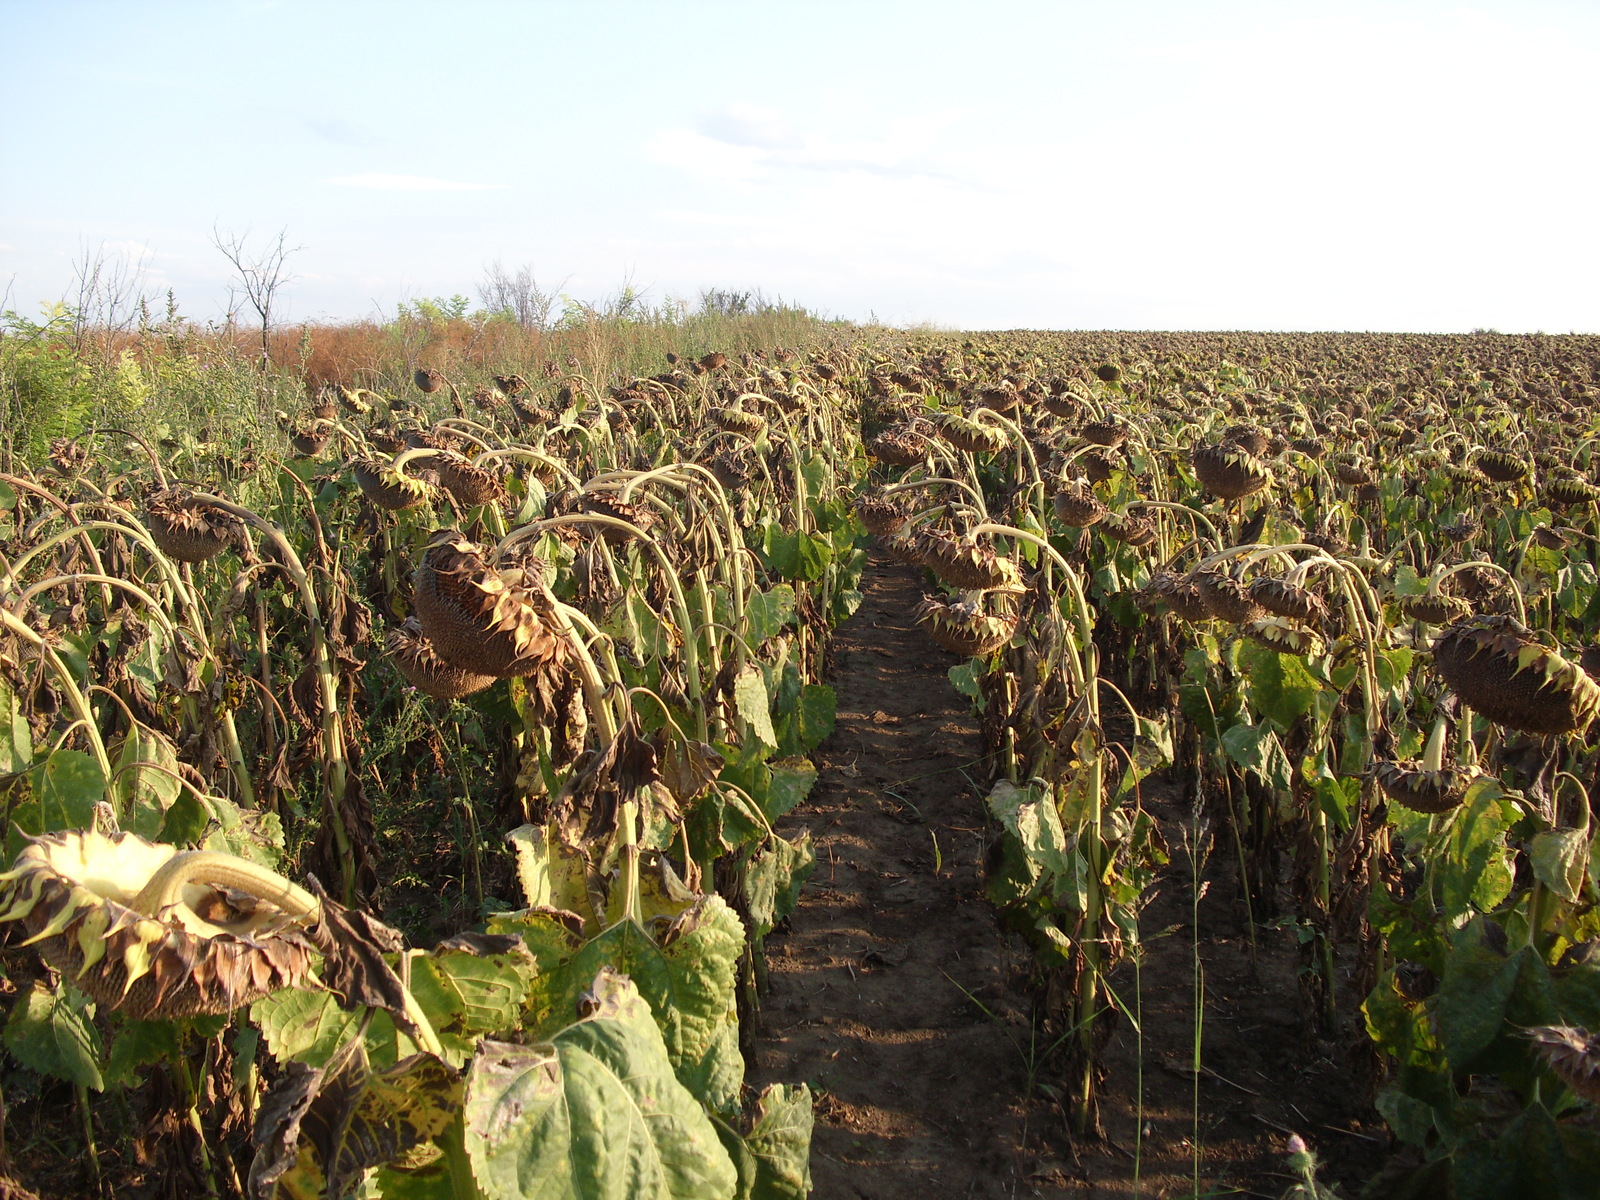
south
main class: Cropland
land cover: Sunflower
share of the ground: > 75 %
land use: Agriculture (excluding fallow land and kitchen gardens)
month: August
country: BG
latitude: 43.7193
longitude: 23.3631
